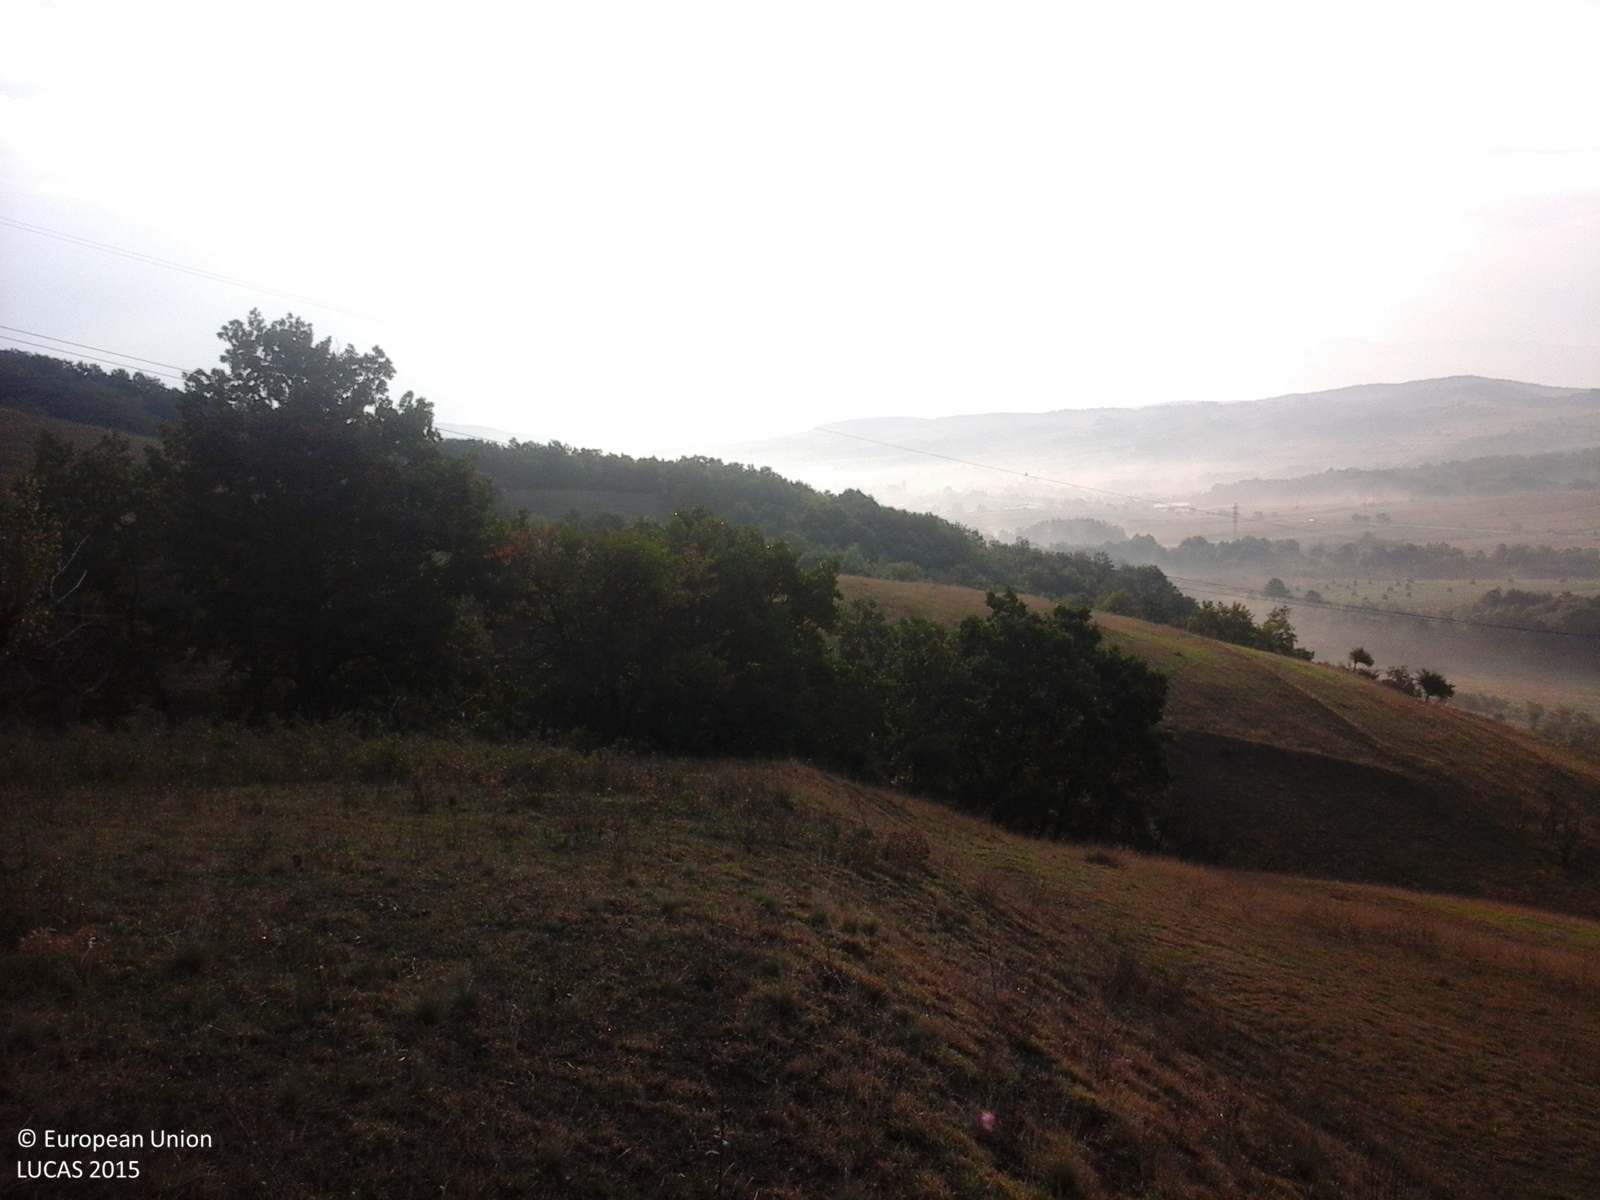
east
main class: Grassland
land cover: Grassland without tree/shrub cover
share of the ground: > 75 %
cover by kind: herbaceous plants 100 %
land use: Agriculture (excluding fallow land and kitchen gardens)
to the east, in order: Grassland without tree/shrub cover; Grassland with sparse tree/shrub cover; Broadleaved woodland; Grassland without tree/shrub cover; Electric lines; Grassland without tree/shrub cover; Shrubland without tree cover; Grassland without tree/shrub cover; Grassland with sparse tree/shrub cover
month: September
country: RO
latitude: 45.6576
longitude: 22.8987
